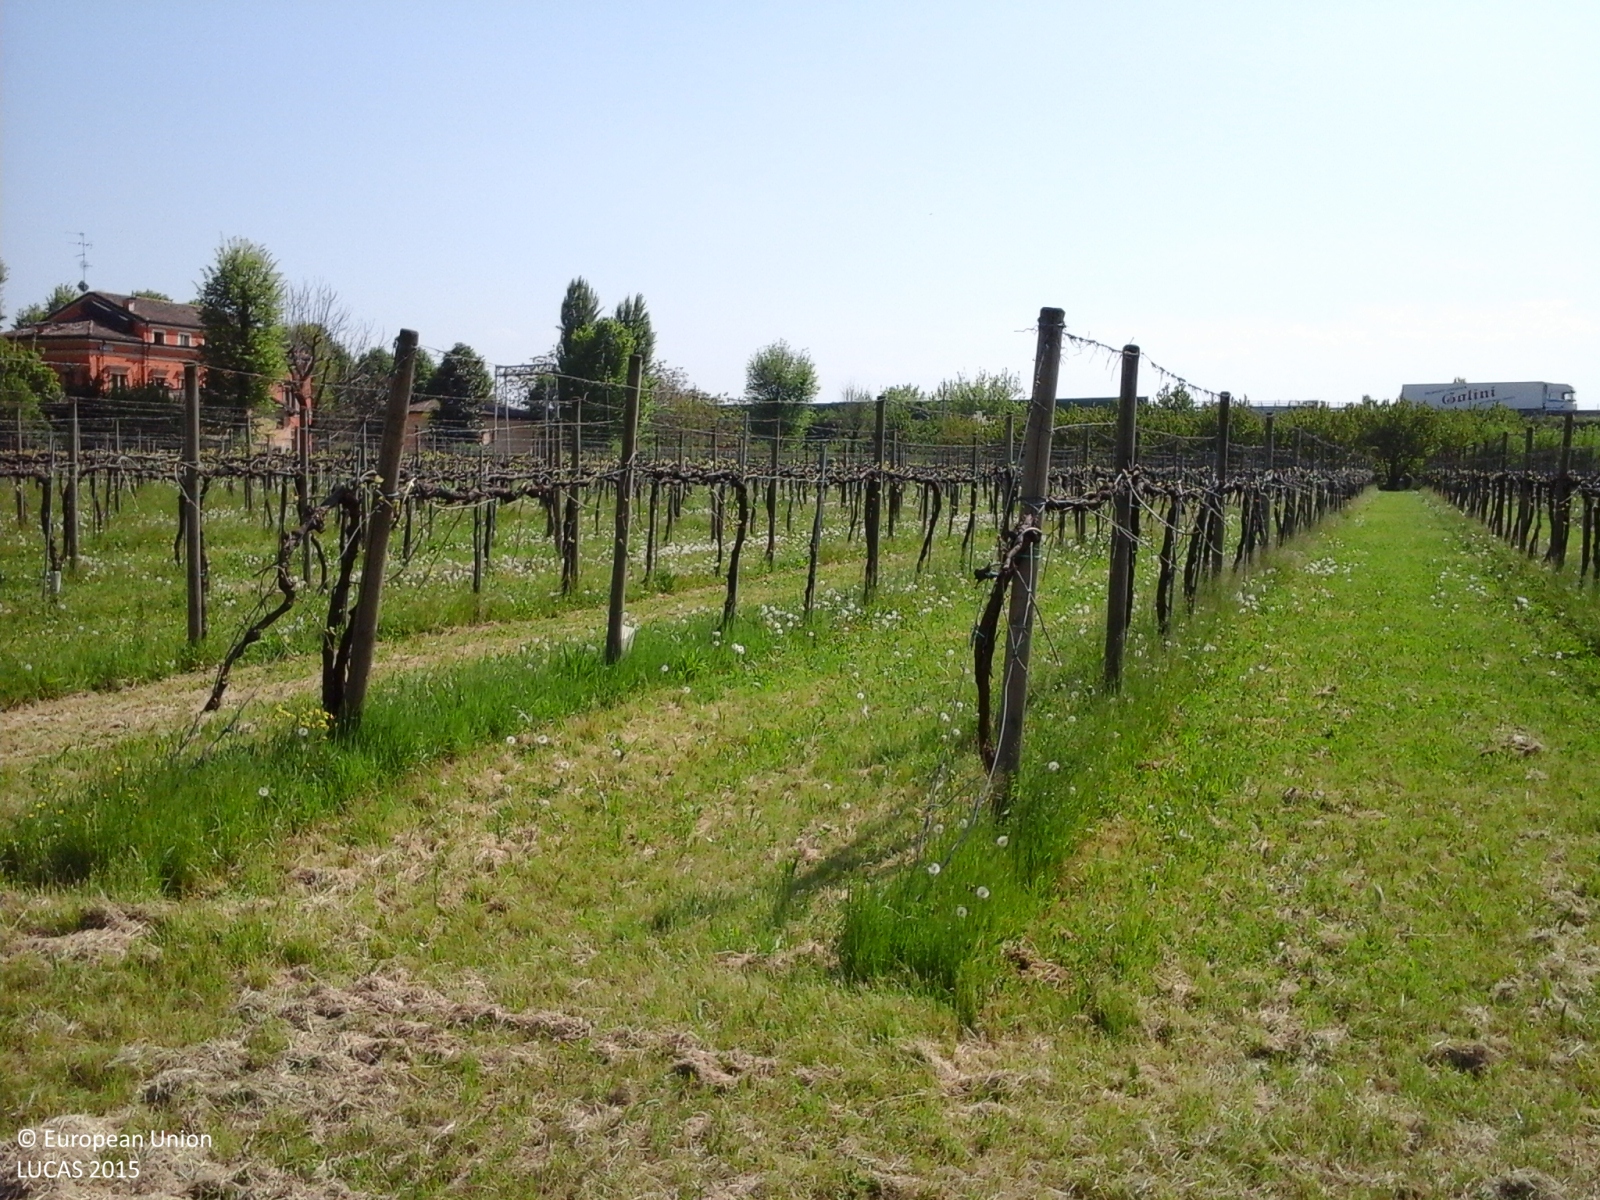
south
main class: Grassland
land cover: Spontaneously vegetated surfaces
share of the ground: > 75 %
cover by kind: herbaceous plants 100 %
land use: Agriculture (excluding fallow land and kitchen gardens)
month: April
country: IT
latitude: 44.6172
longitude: 10.8928
